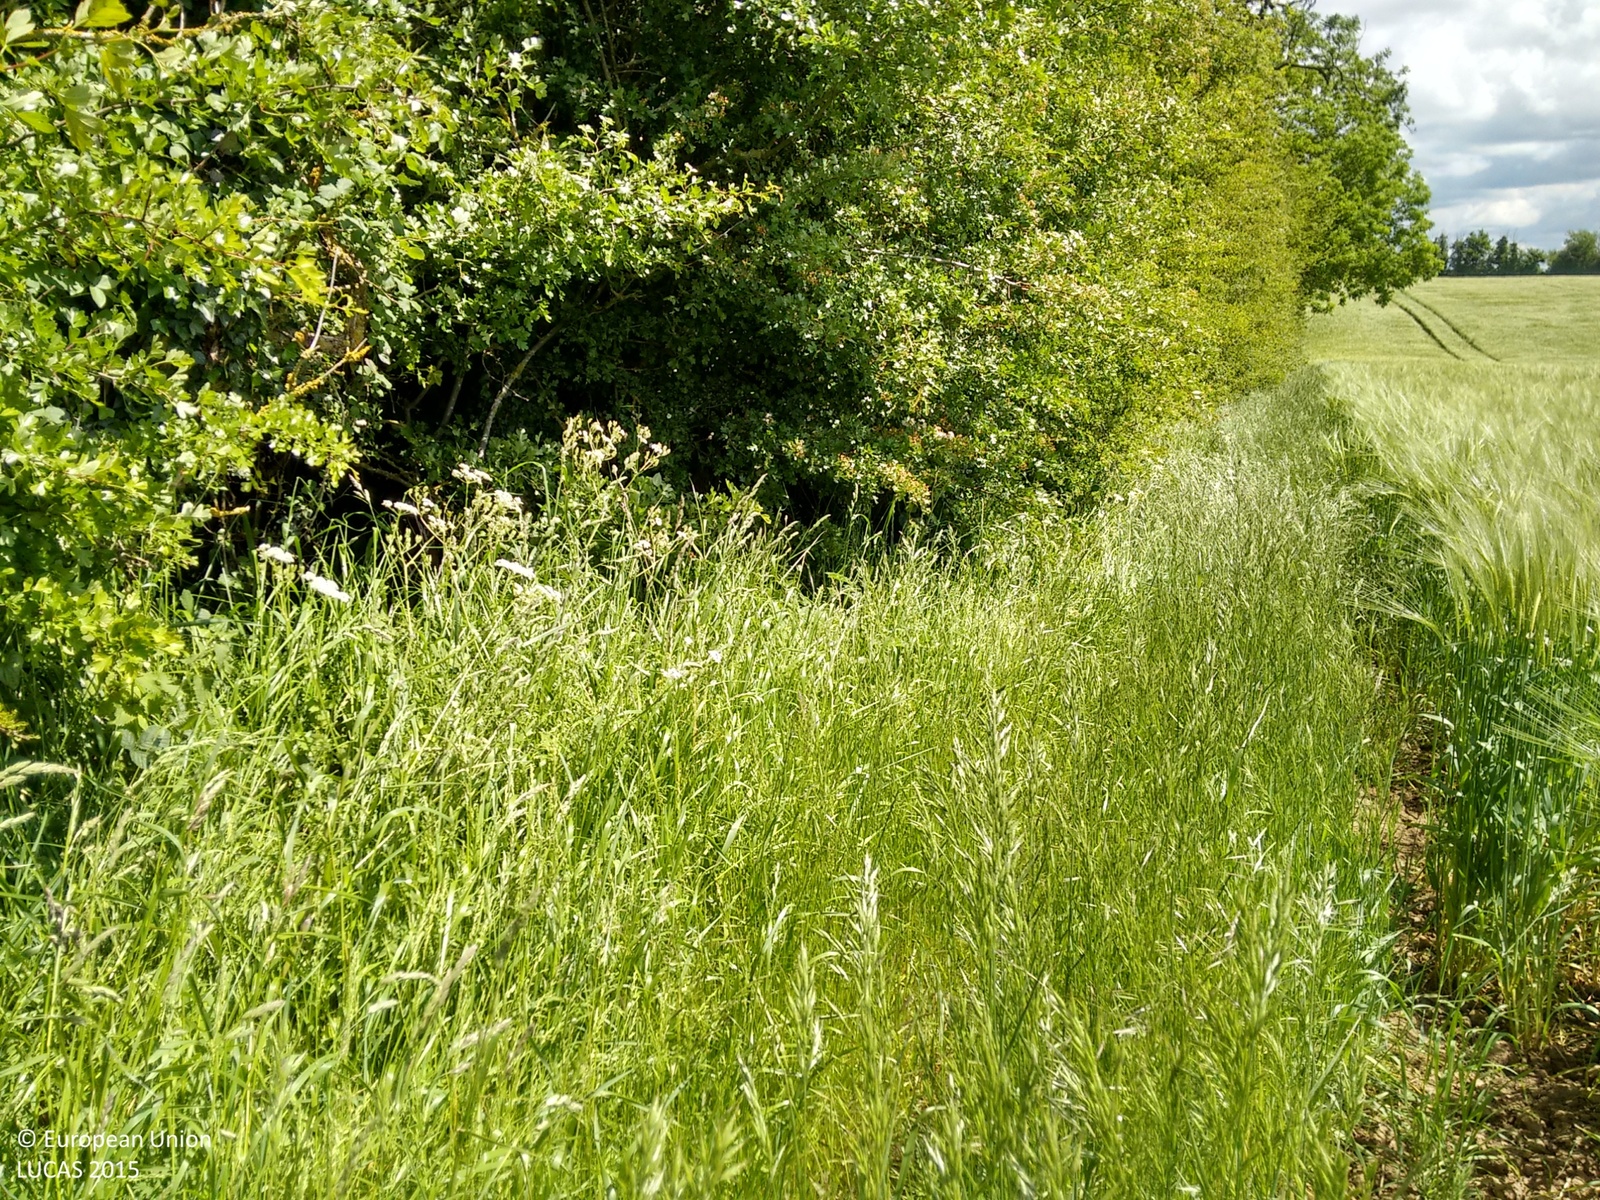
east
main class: Cropland
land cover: Barley
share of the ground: > 75 %
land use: Agriculture (excluding fallow land and kitchen gardens)
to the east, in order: Barley; Grass margins; Managed hedges; Grass margins; Arable land (only in case pi)
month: June
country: GB
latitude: 52.4473
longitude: -1.3635
